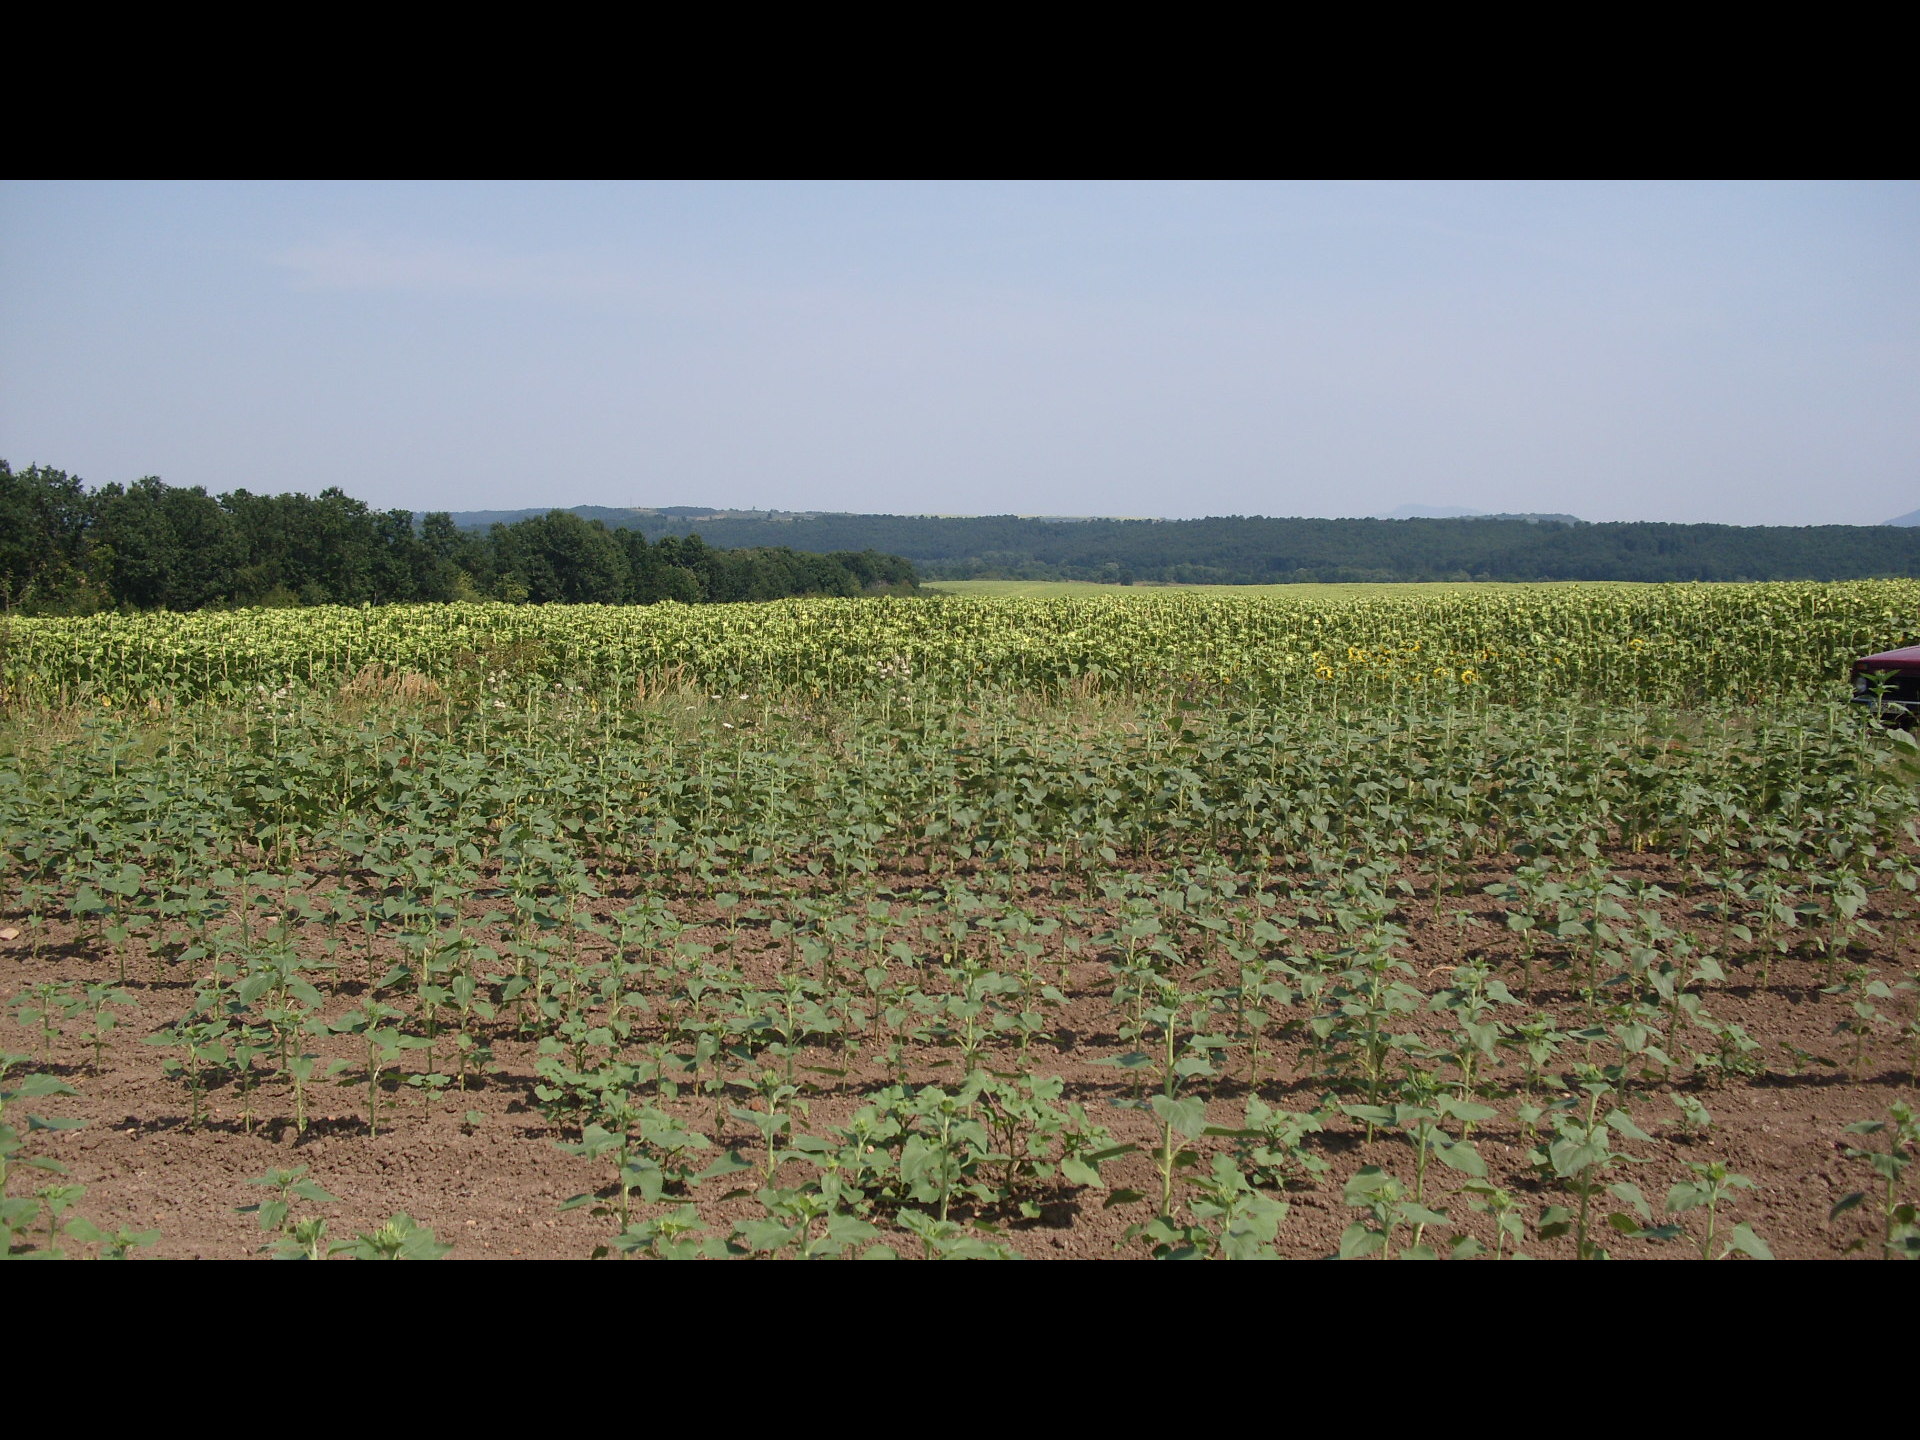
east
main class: Cropland
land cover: Sunflower
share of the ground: 25 - 50 %
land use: Agriculture (excluding fallow land and kitchen gardens)
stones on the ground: < 10 %
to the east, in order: Sunflower; Grass margins; Tracks; Grass margins; Sunflower; Grass margins; Tracks; Grass margins; Shrubland without tree cover
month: August
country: BG
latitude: 43.3470
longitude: 23.2767
